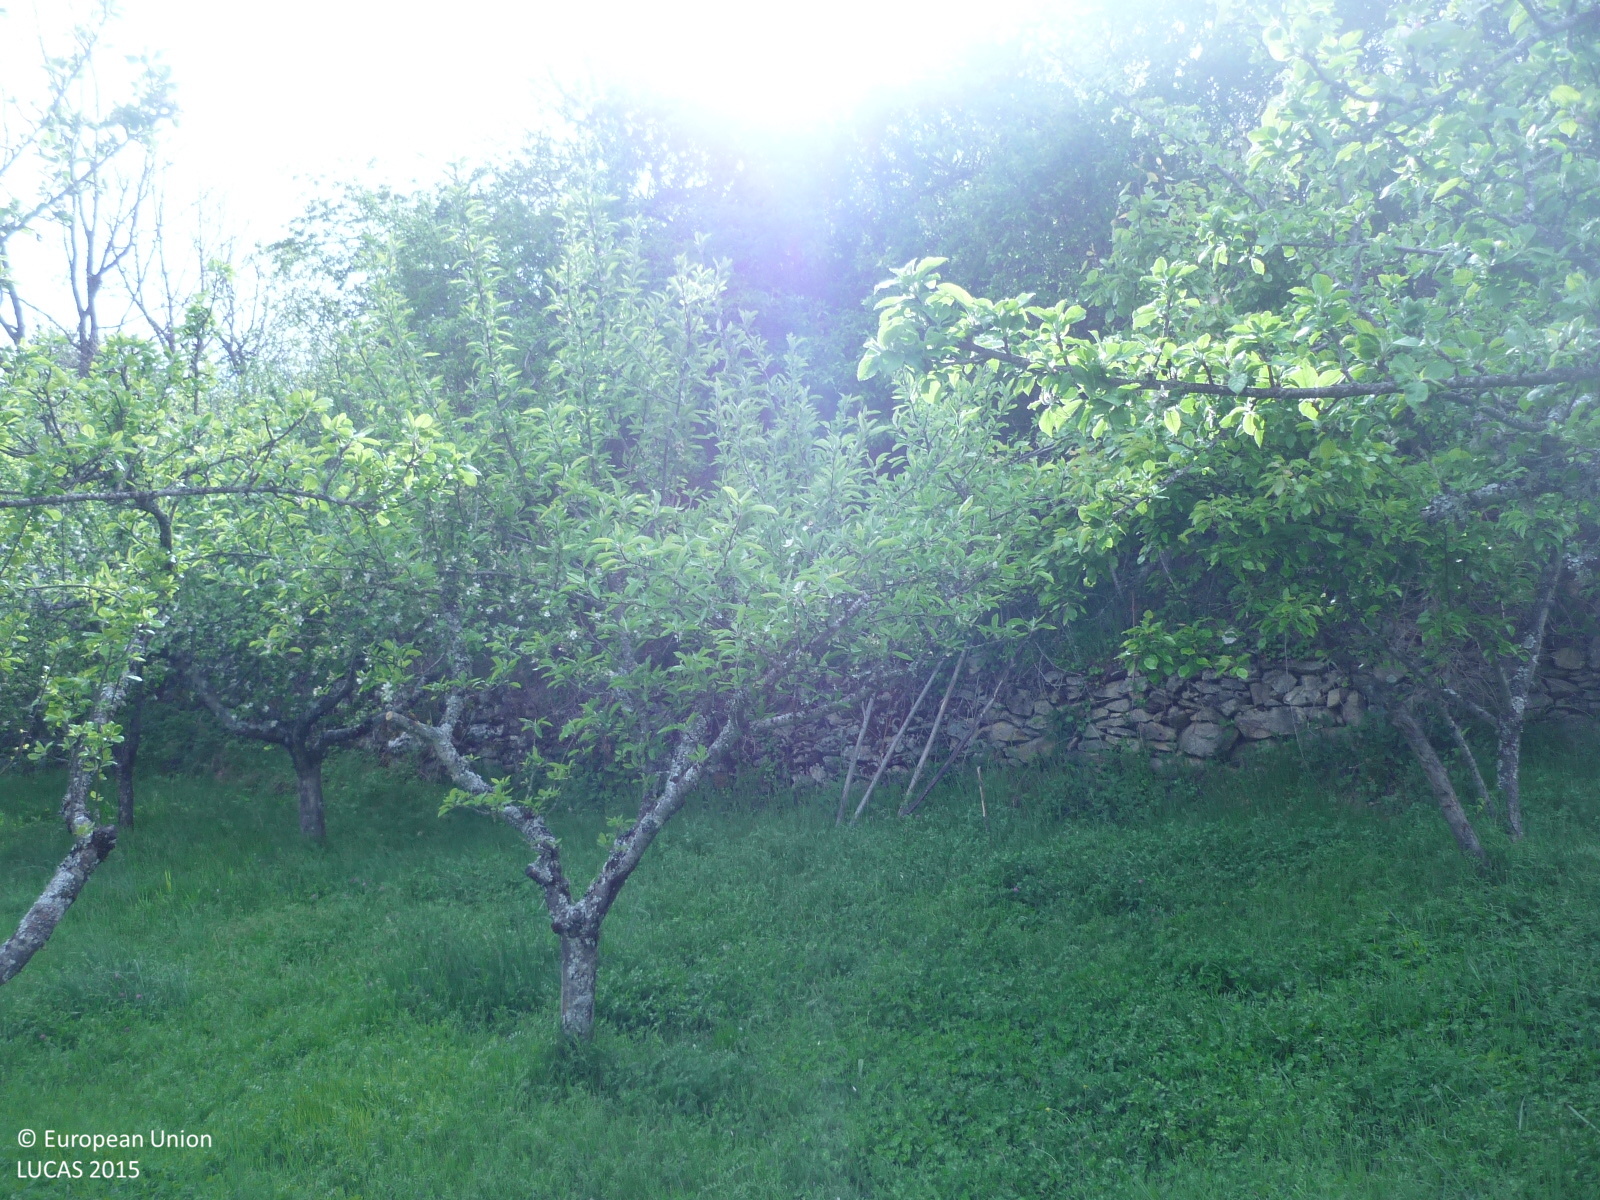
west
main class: Cropland
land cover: Apple fruit
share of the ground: 25 - 50 %
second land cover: Grassland without tree/shrub cover
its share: > 75 %
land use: Agriculture (excluding fallow land and kitchen gardens)
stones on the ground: < 10 %
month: May
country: ES
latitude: 41.0878
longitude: -3.6277
